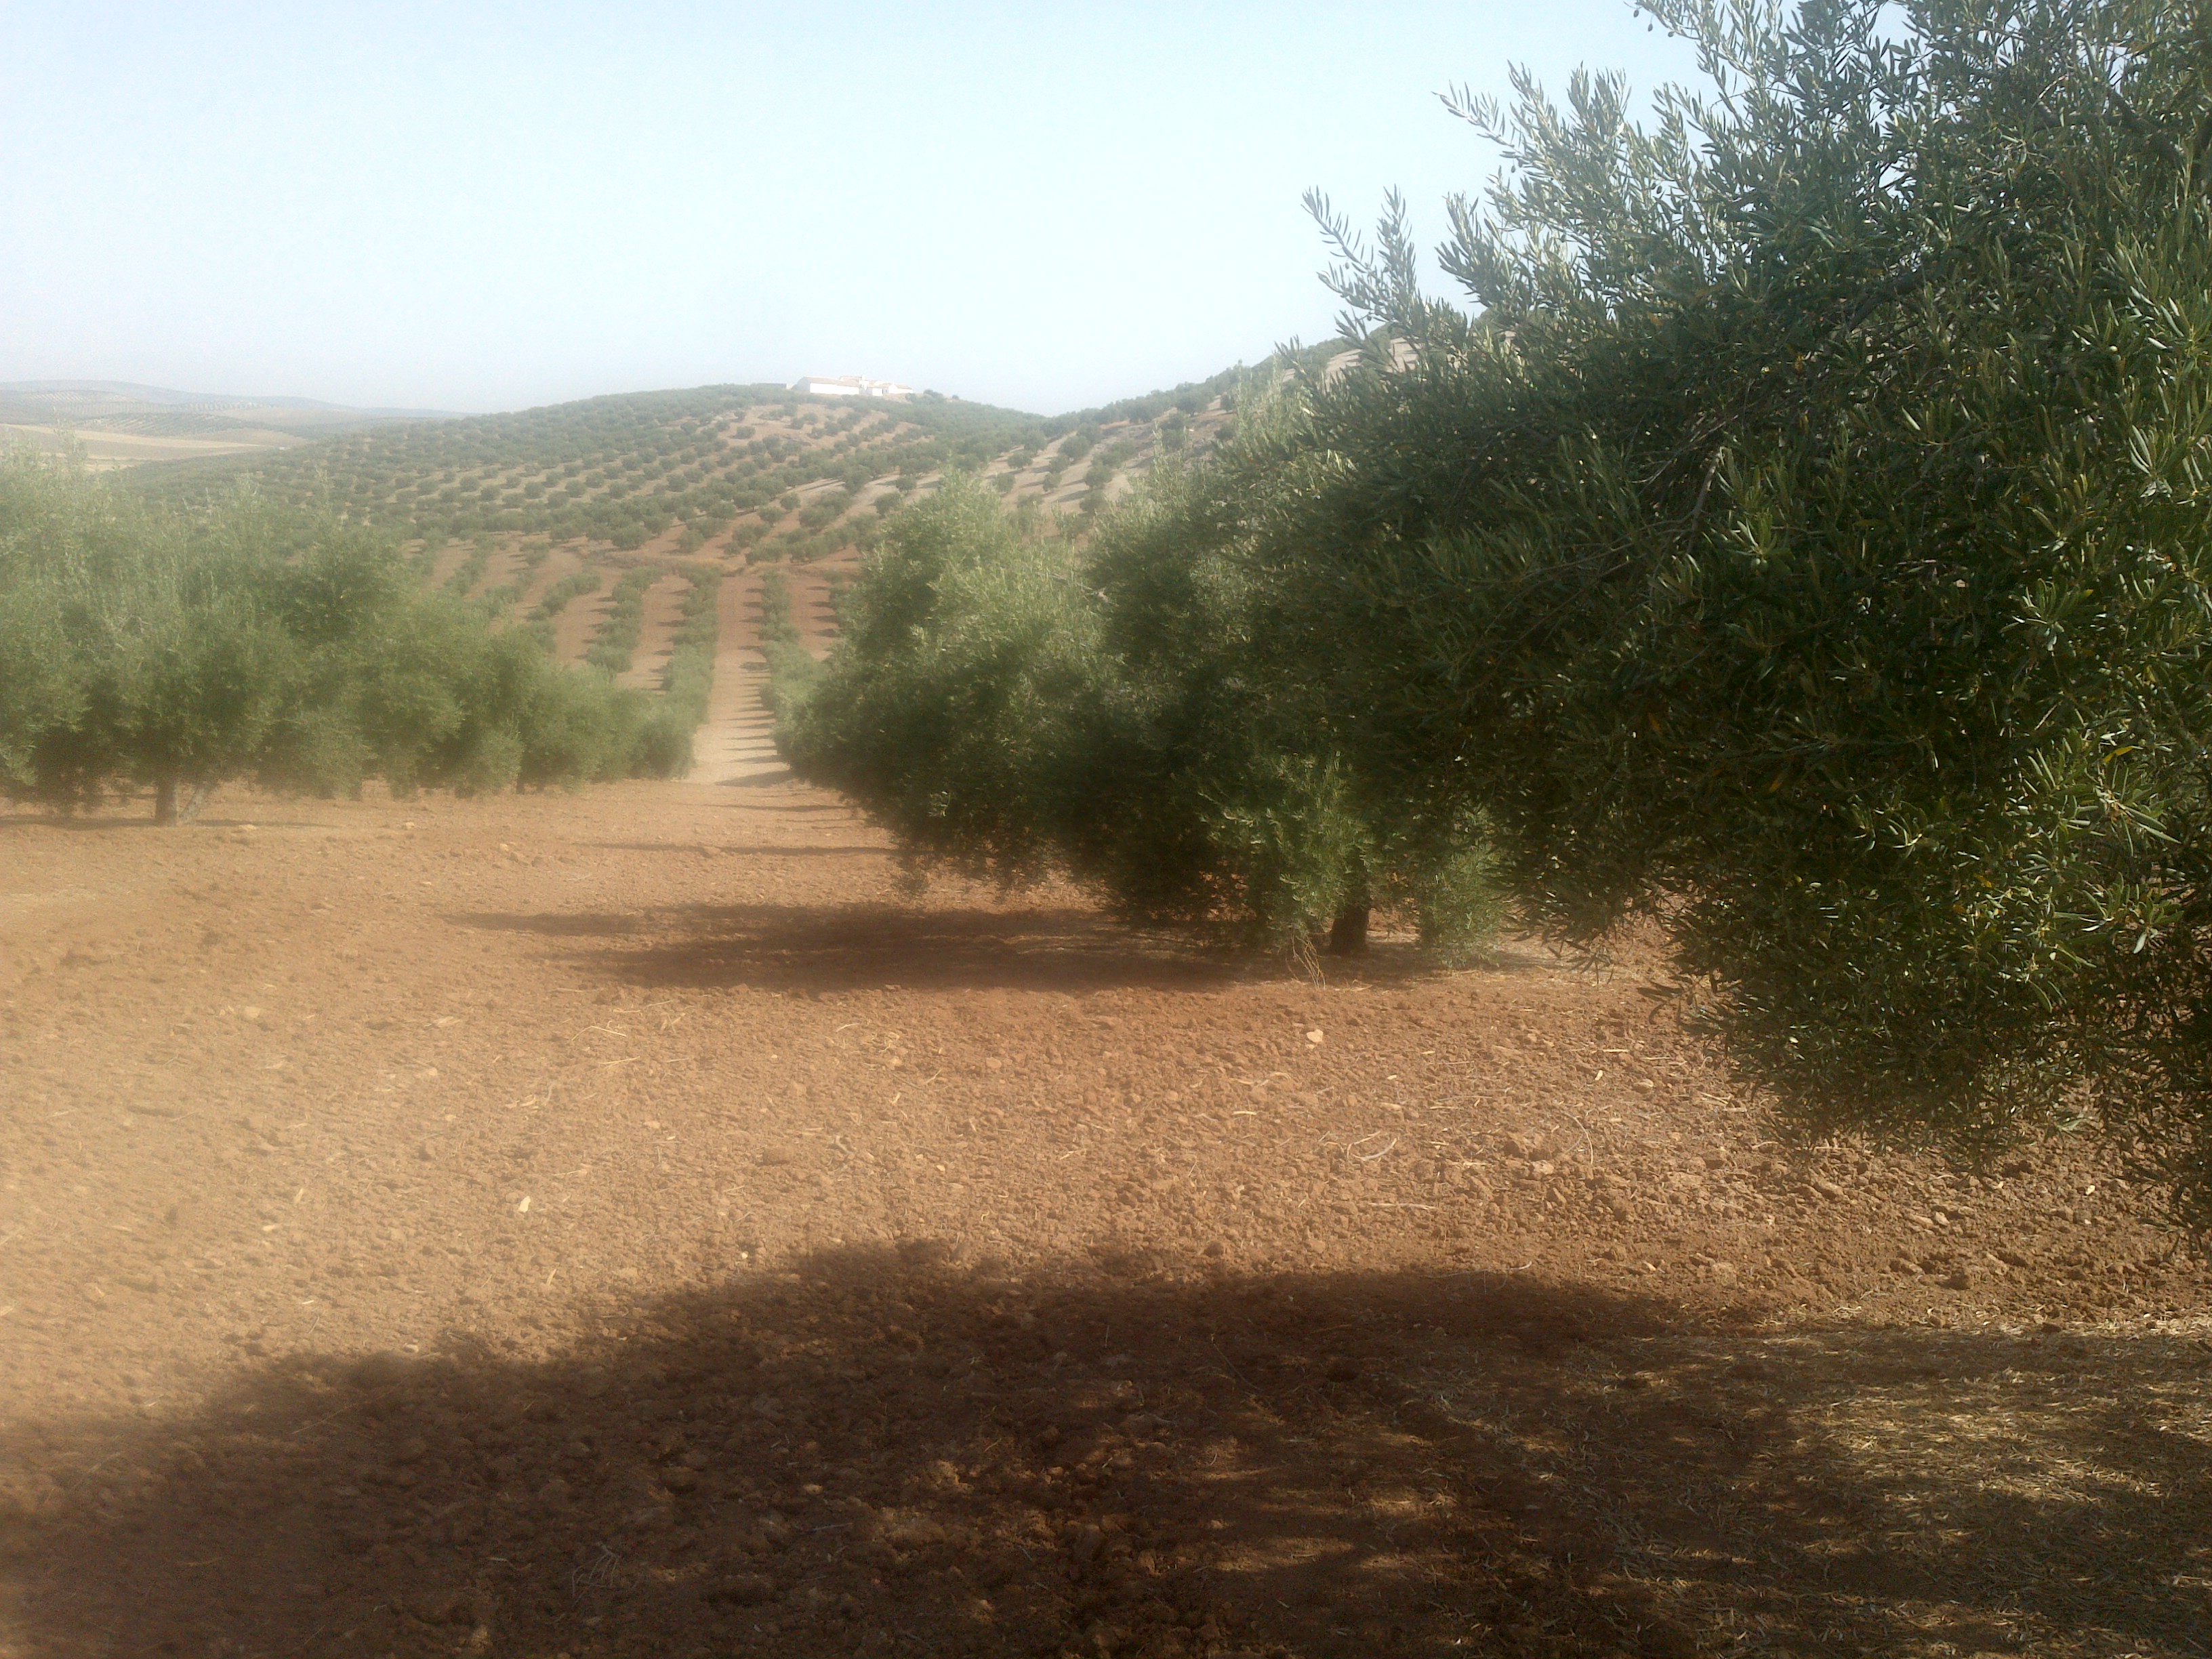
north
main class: Cropland
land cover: Olive groves
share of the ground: 50 - 75 %
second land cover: Other bare soil
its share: > 75 %
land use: Agriculture (excluding fallow land and kitchen gardens)
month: June
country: ES
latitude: 37.6994
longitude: -4.2384
